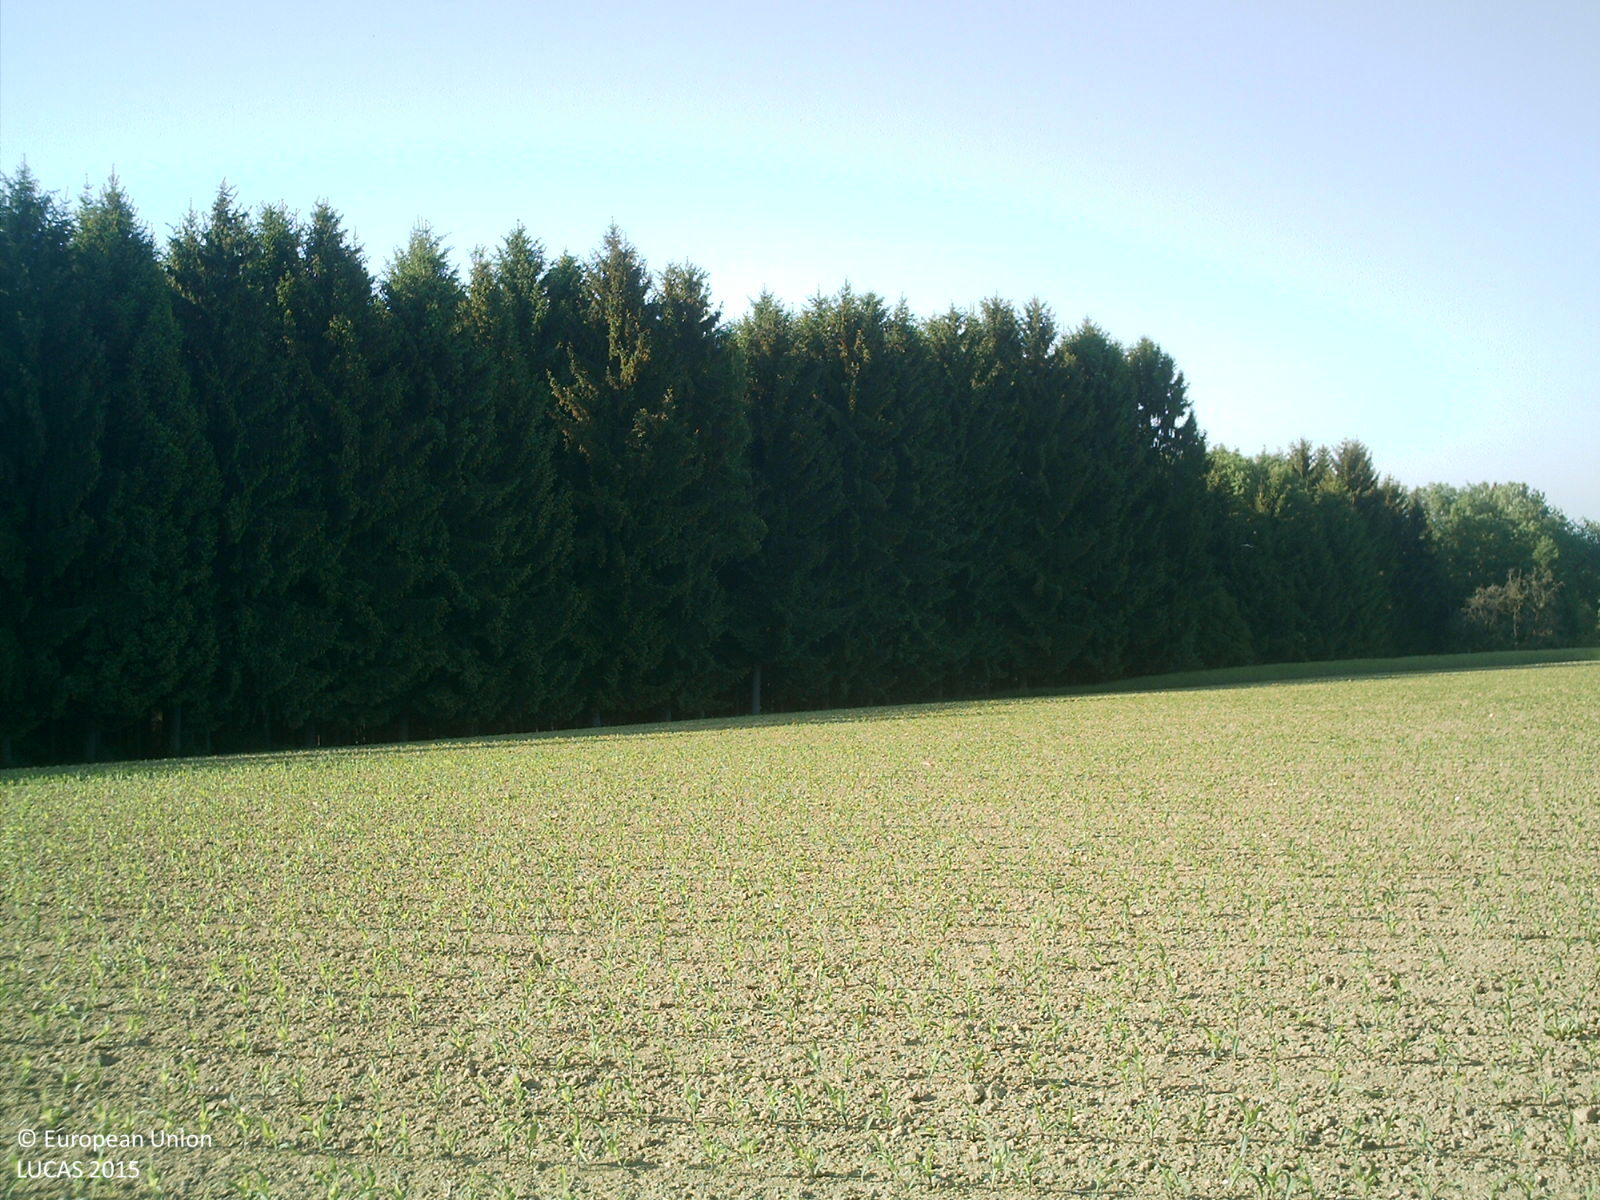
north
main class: Cropland
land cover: Maize
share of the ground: < 10 %
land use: Agriculture (excluding fallow land and kitchen gardens)
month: May
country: AT
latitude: 48.0036
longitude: 14.0876
